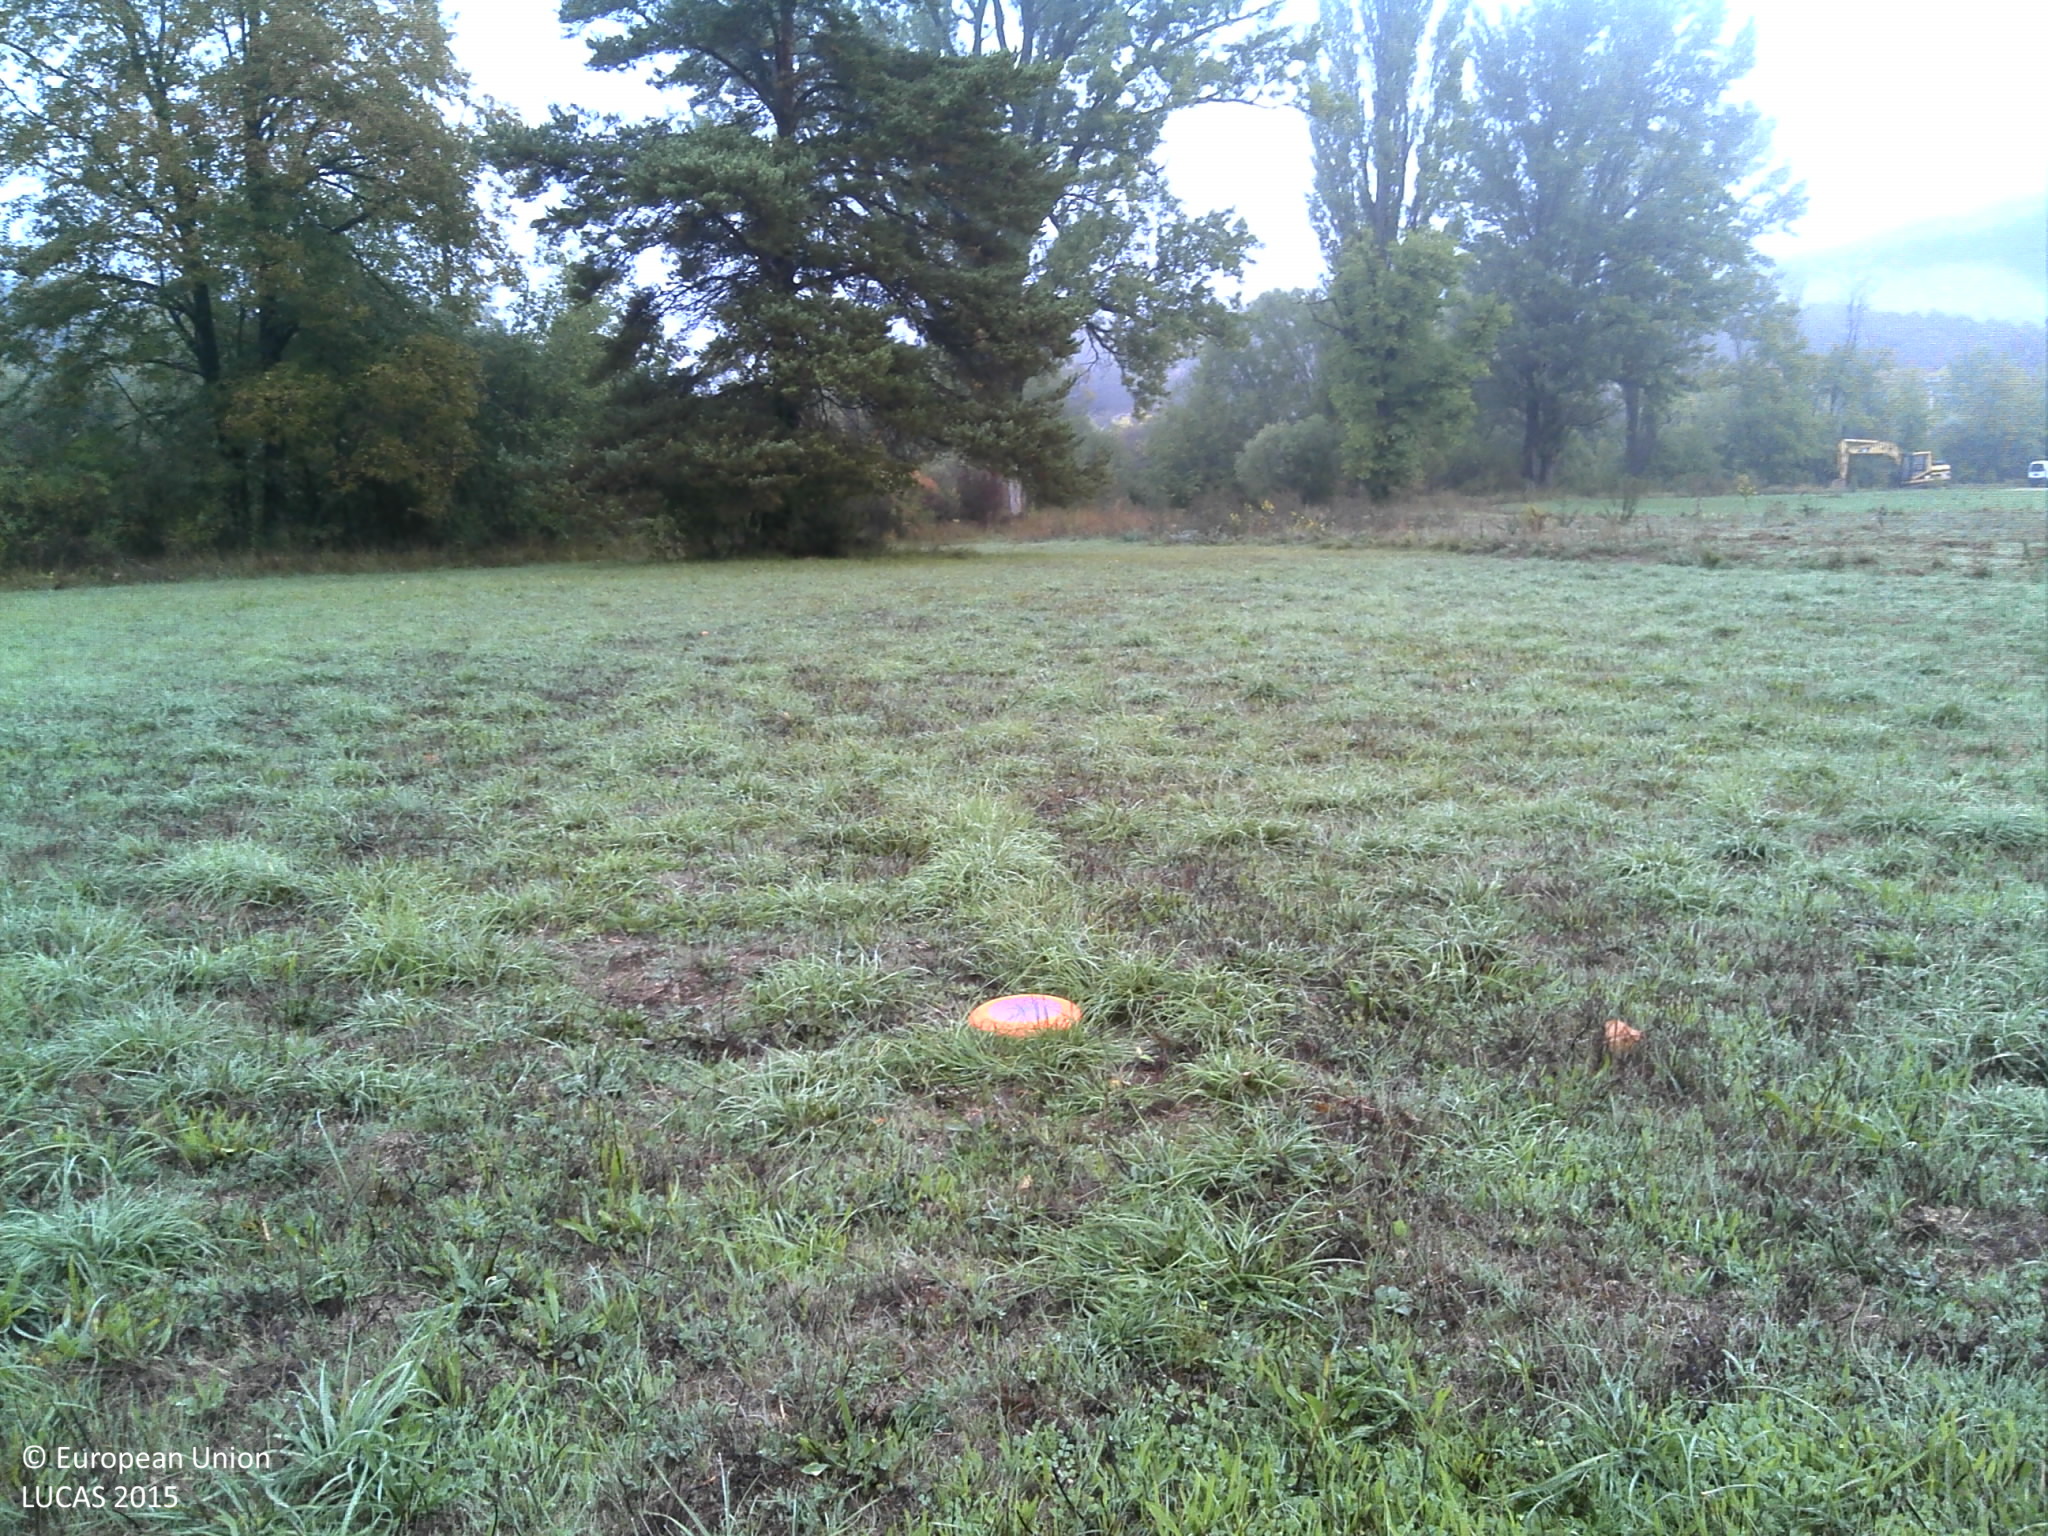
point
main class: Grassland
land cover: Grassland without tree/shrub cover
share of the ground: > 75 %
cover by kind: herbaceous plants 95 %, unconsolidated bare surface 5 %
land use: Agriculture (excluding fallow land and kitchen gardens)
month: September
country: FR
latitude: 43.7145
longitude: 6.5204
